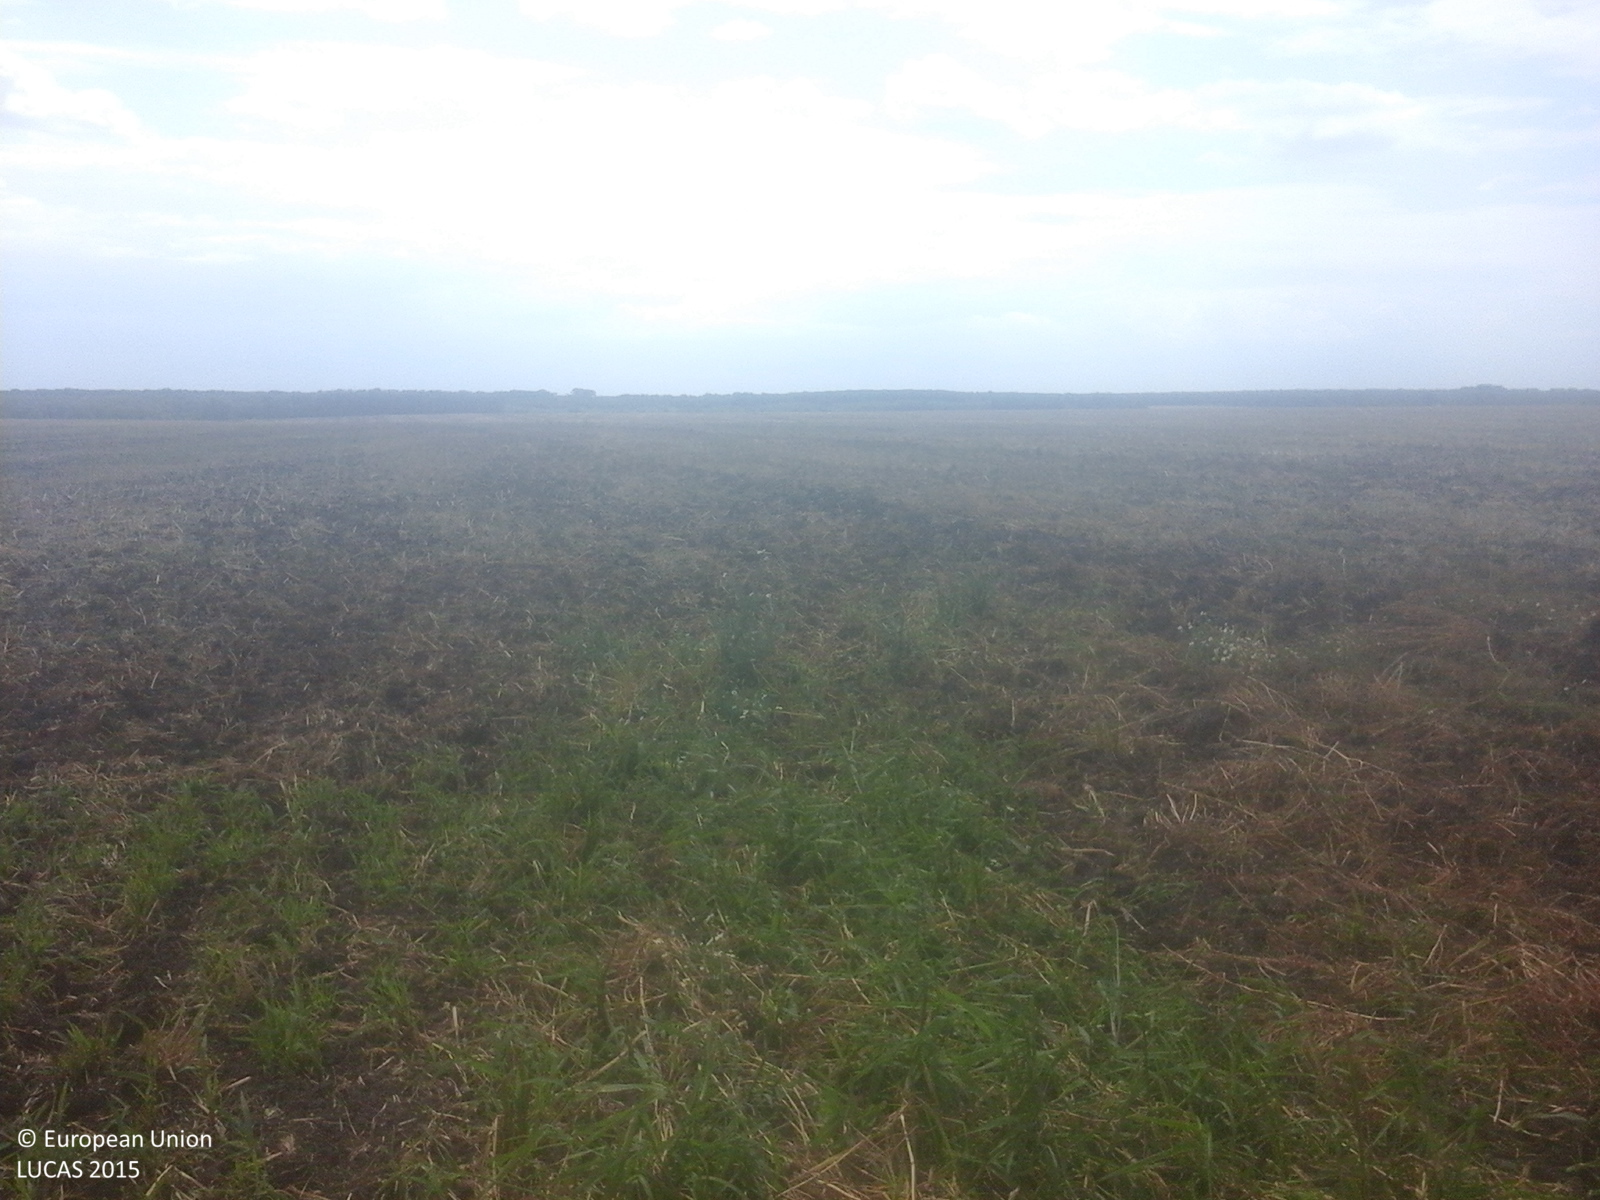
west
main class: Cropland
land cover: Rape and turnip rape
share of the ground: < 10 %
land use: Agriculture (excluding fallow land and kitchen gardens)
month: July
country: RO
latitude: 44.1238
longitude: 25.5478
